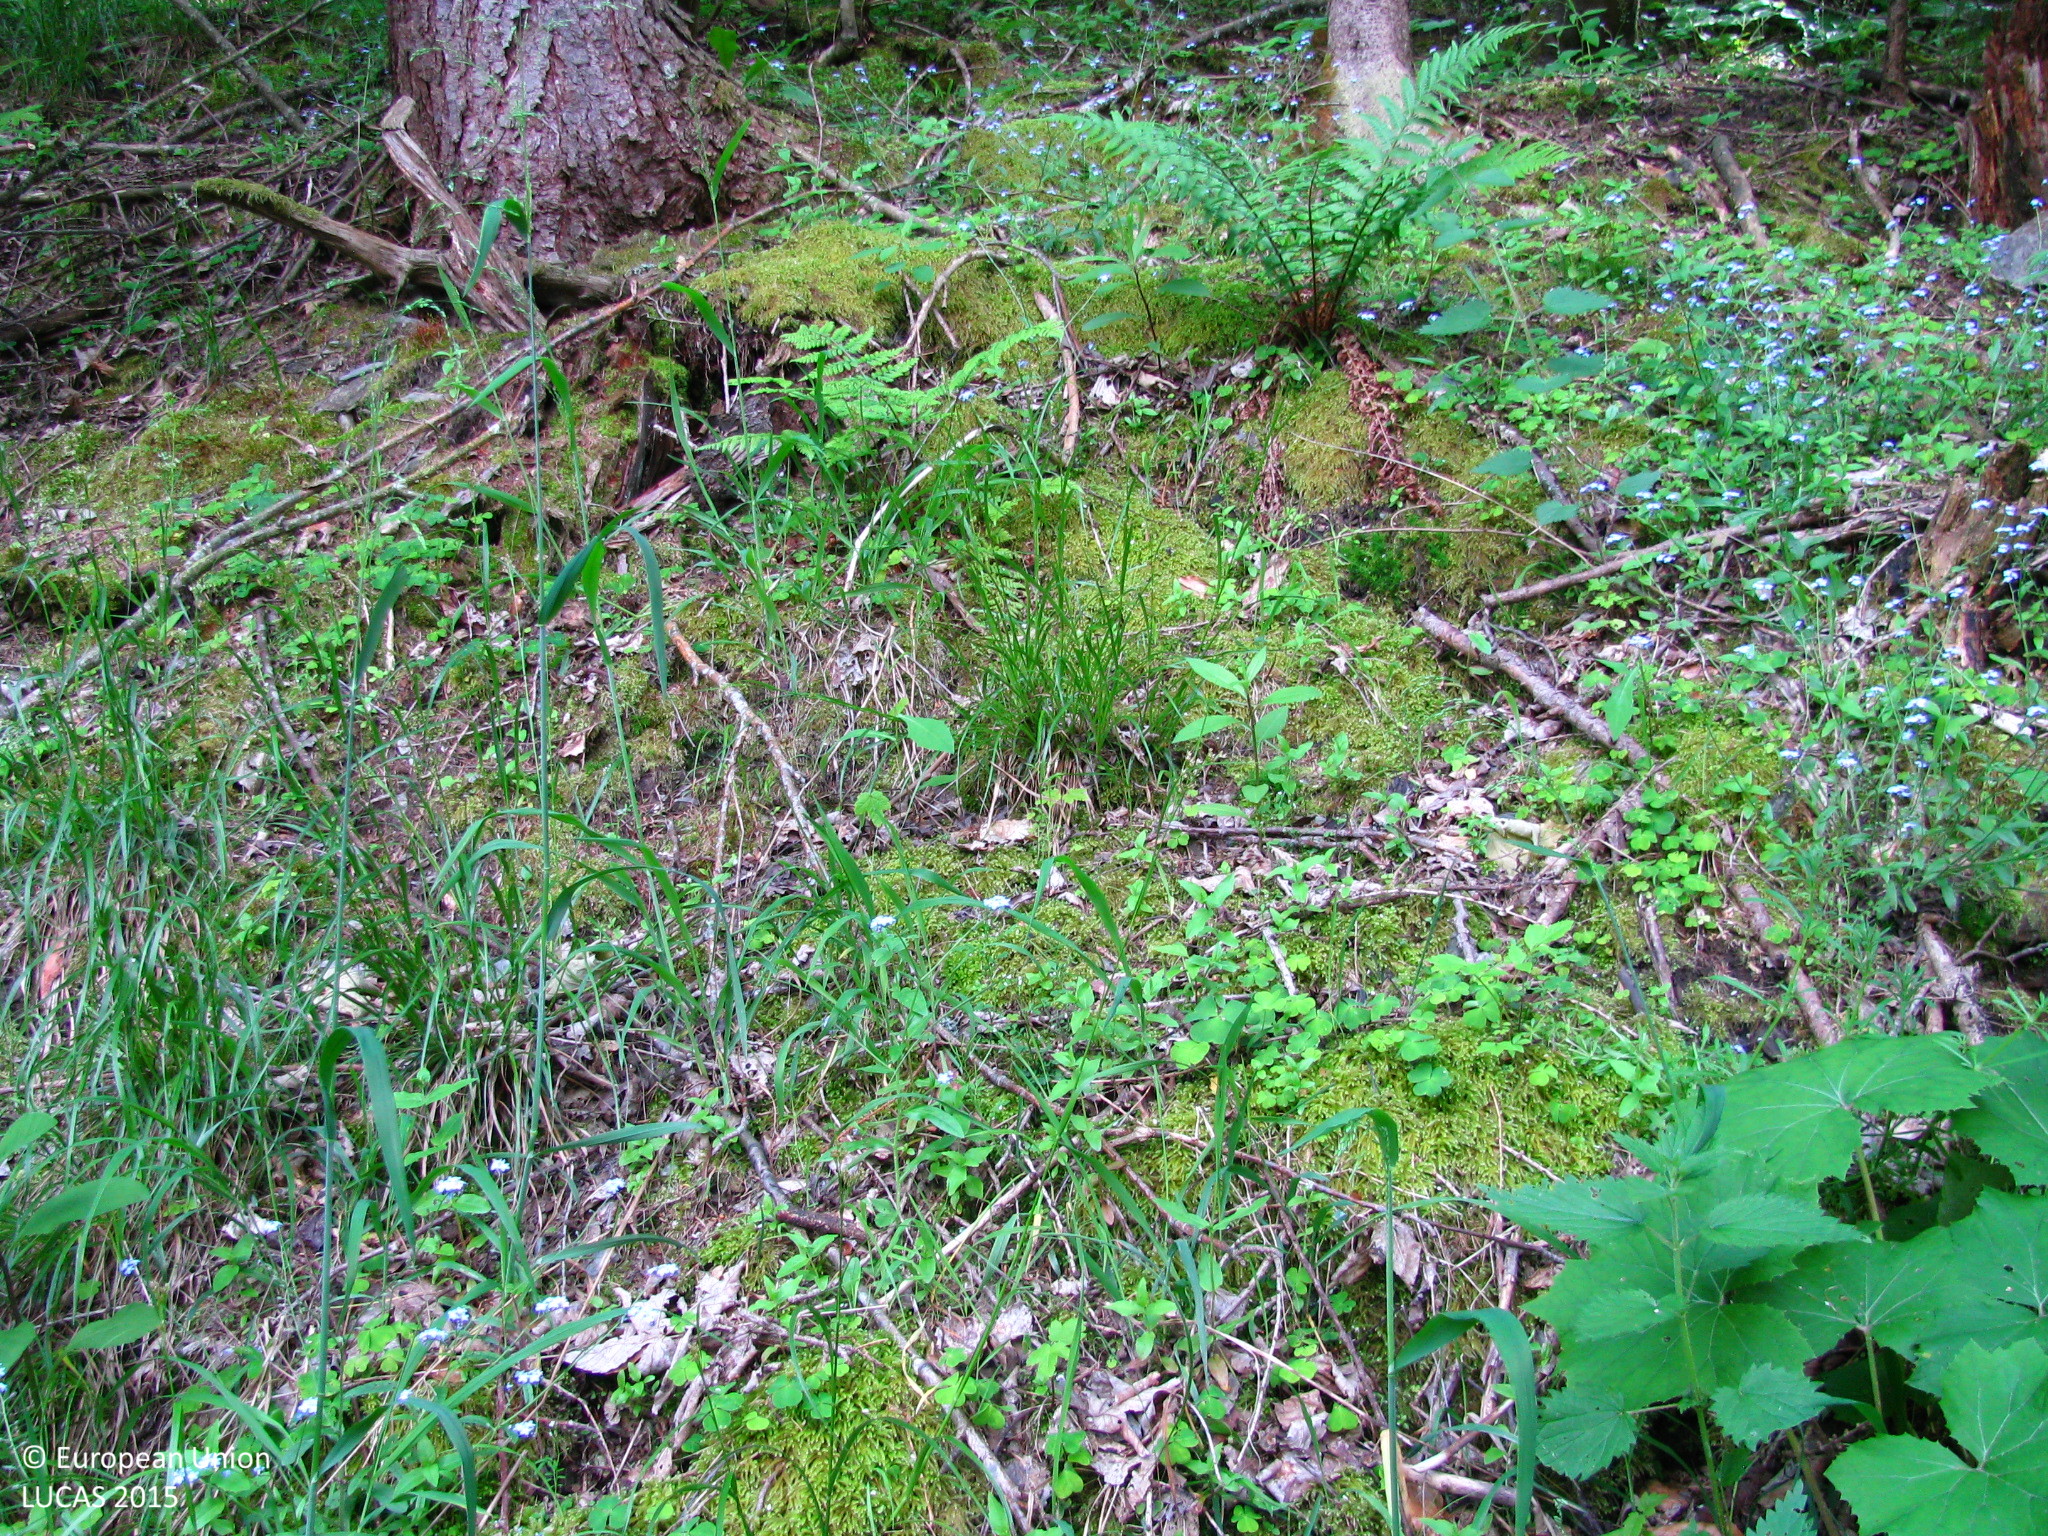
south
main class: Woodland
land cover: Spruce dominated mixed woodland
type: alpine coniferous forest
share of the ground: > 75 %
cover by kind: broadleaved forest trees 50 %, coniferous forest trees 30 %, herbaceous plants 15 %, lichens and mosses 5 %
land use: Forestry
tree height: > 5 m
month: June
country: AT
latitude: 47.4454
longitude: 14.9463
